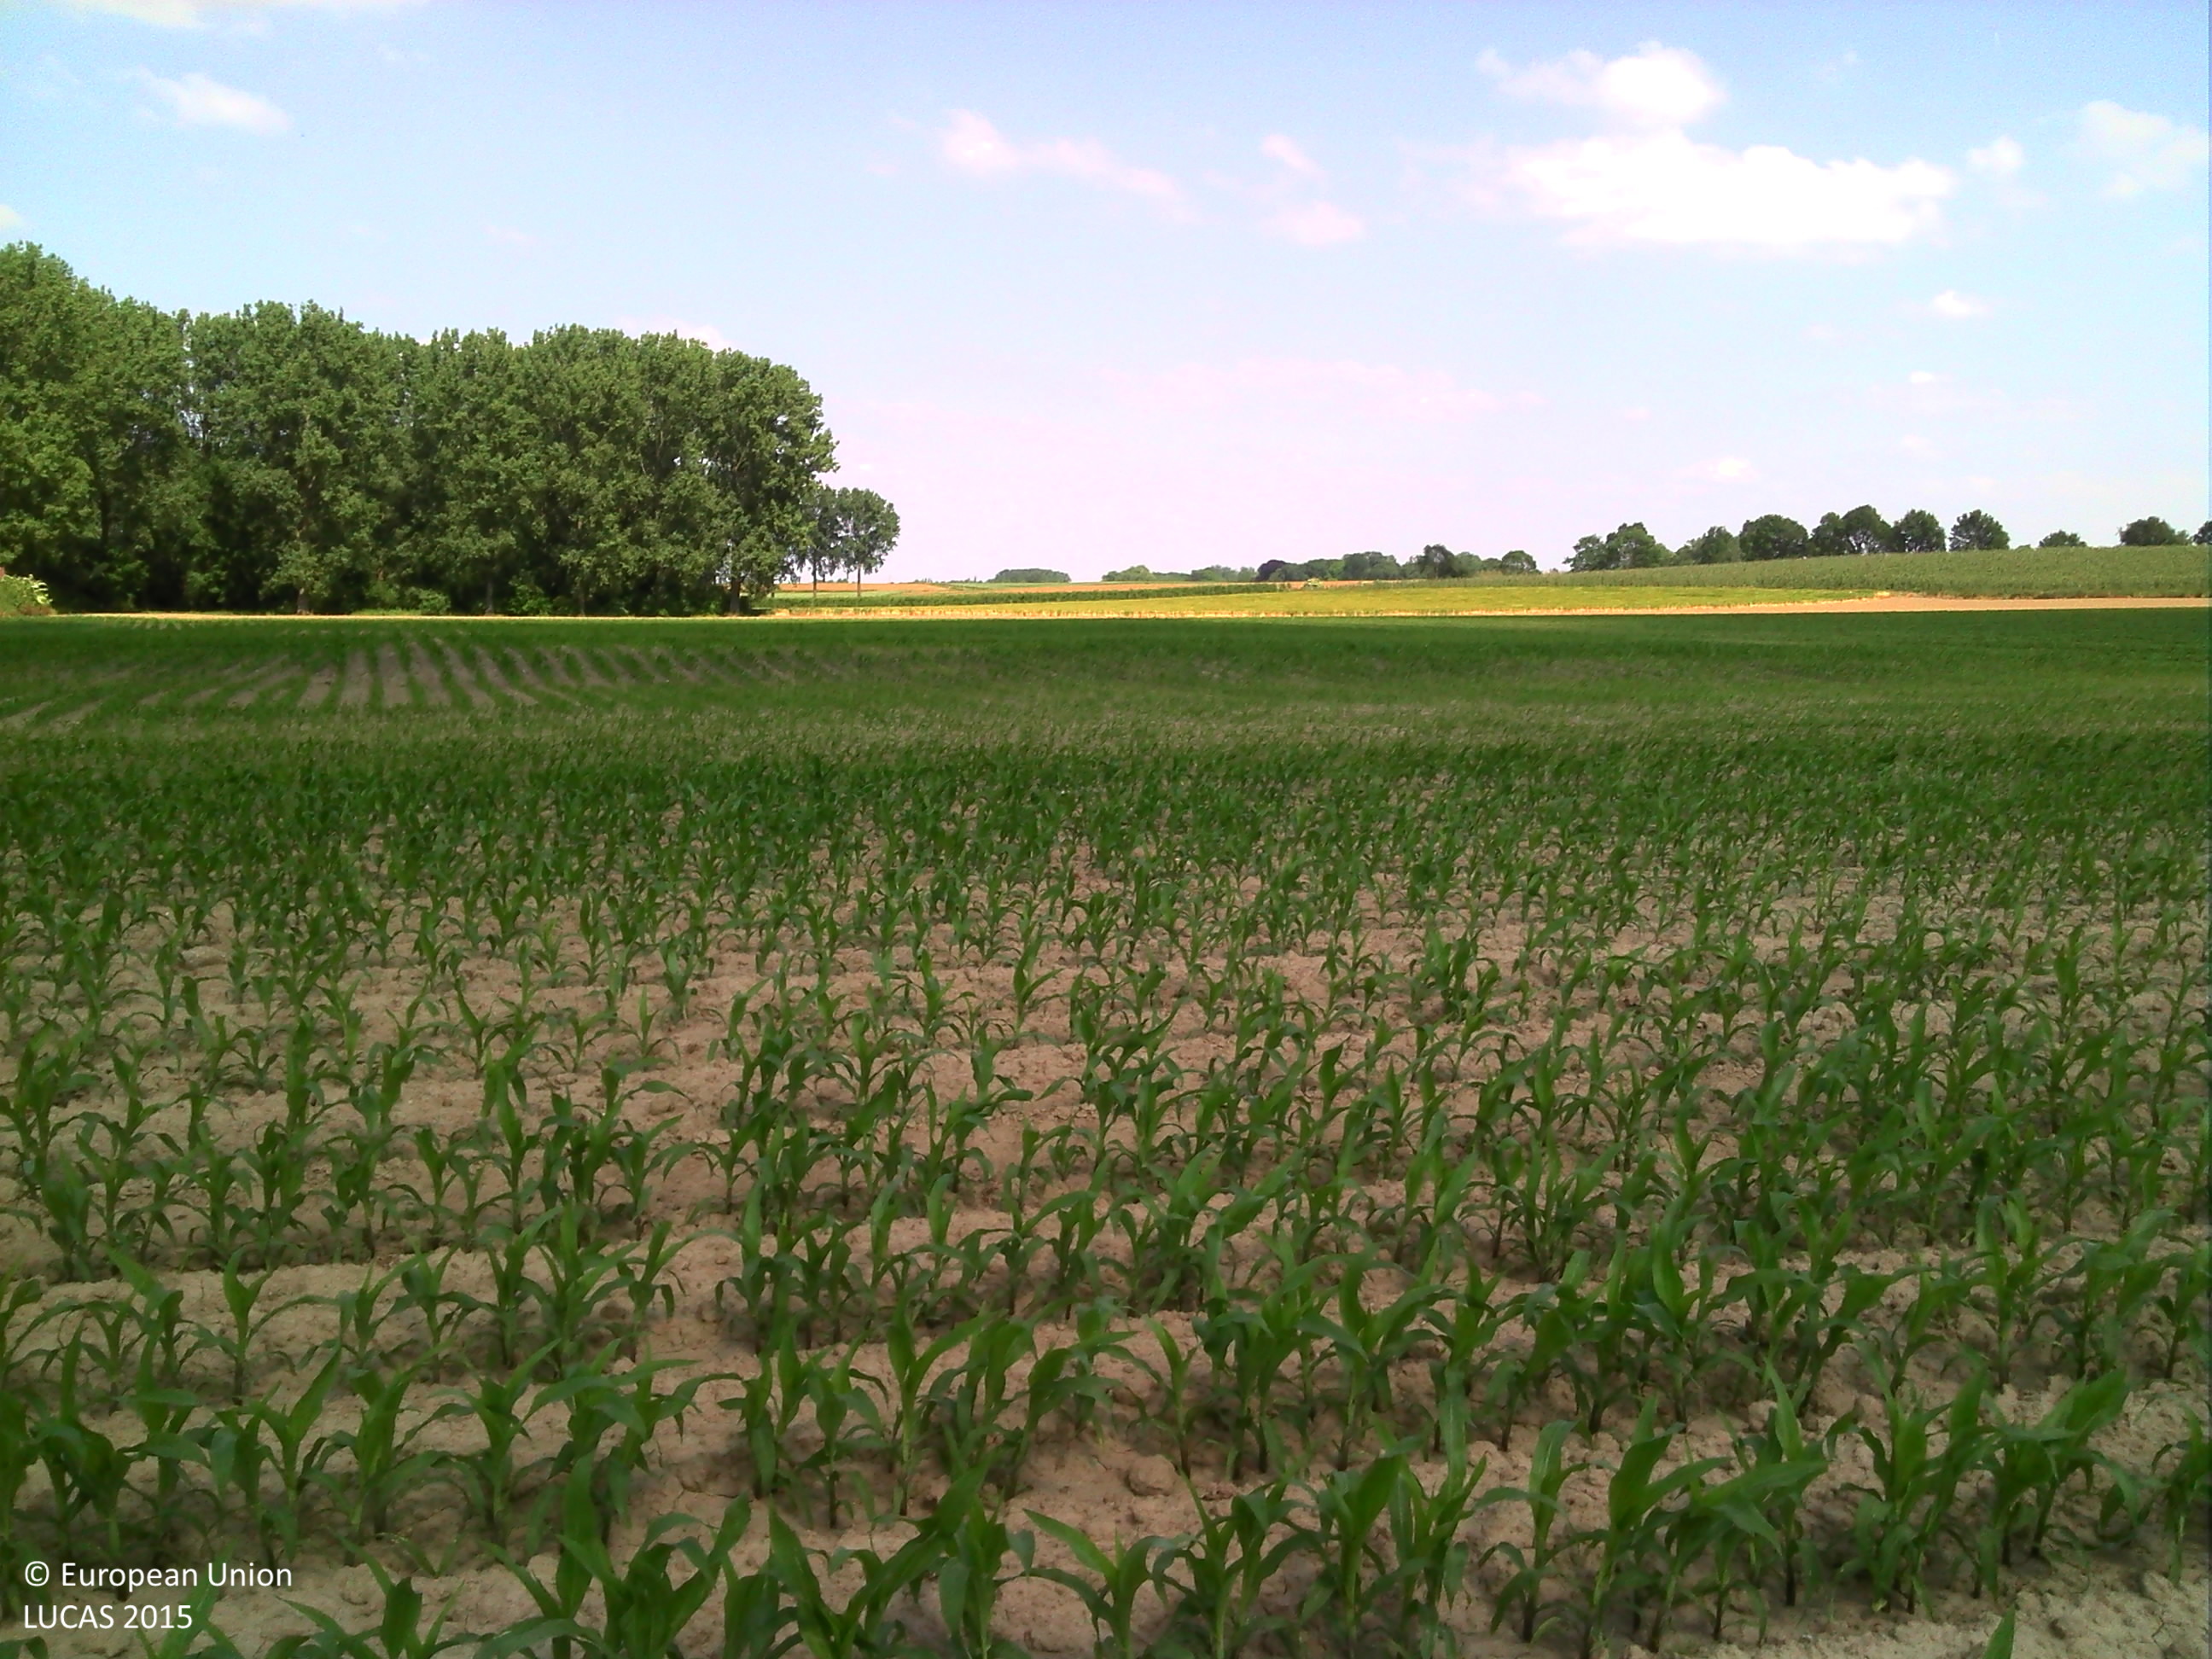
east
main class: Cropland
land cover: Maize
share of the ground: 25 - 50 %
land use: Agriculture (excluding fallow land and kitchen gardens)
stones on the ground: < 10 %
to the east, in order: Maize; Sugar beet; Maize; Other bare soil
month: June
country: BE
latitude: 50.7597
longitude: 5.4474
